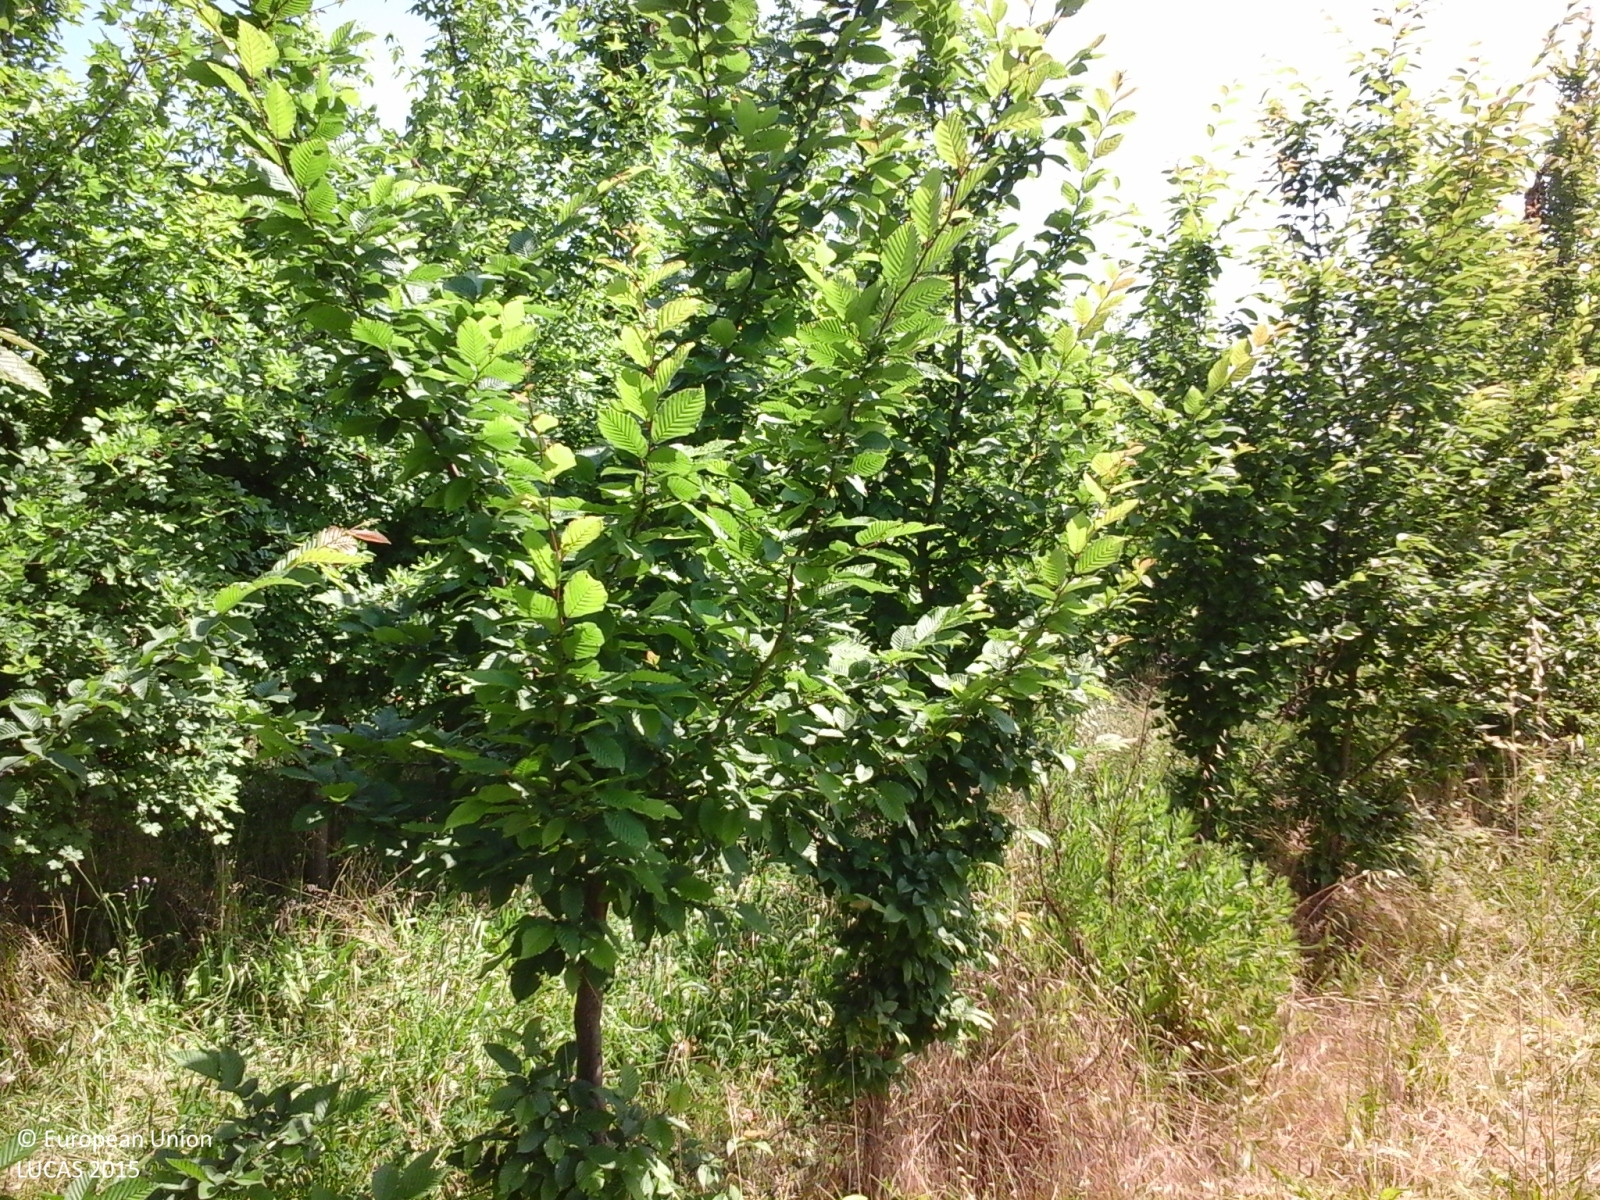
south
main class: Cropland
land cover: Nurseries
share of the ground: 50 - 75 %
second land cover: Spontaneously vegetated surfaces
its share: > 75 %
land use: Agriculture (excluding fallow land and kitchen gardens)
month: June
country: IT
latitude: 44.5060
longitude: 11.1923
